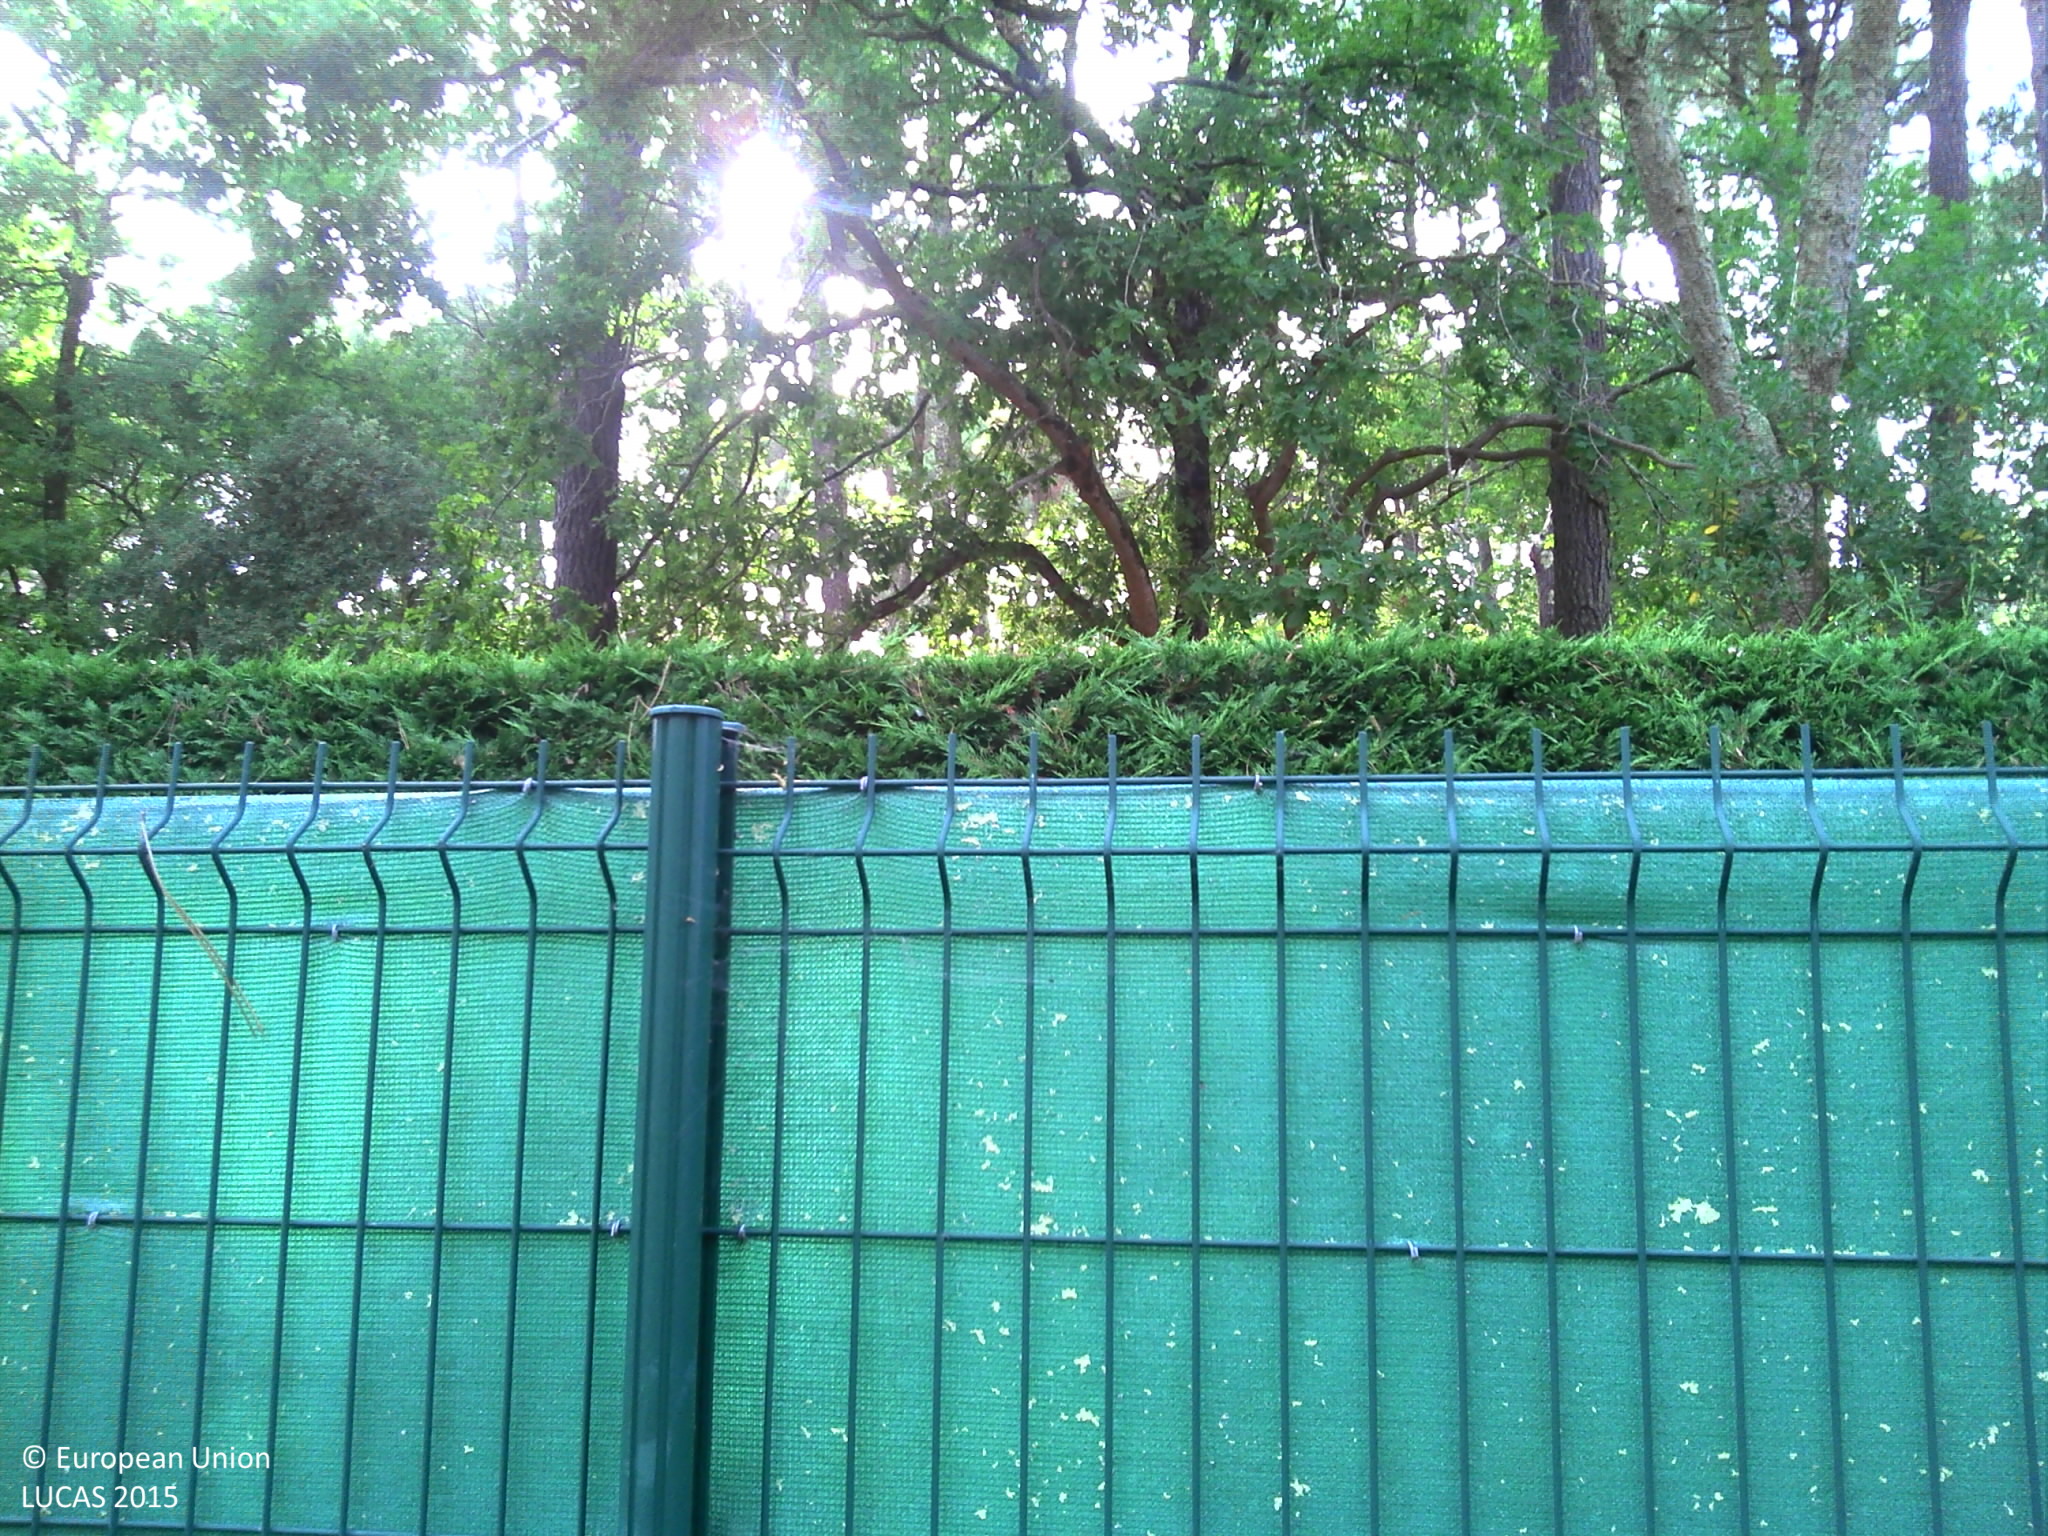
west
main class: Woodland
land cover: Pine dominated mixed woodland
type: coniferous forest of the mediterranean region
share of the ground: > 75 %
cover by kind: coniferous forest trees 50 %, broadleaved forest trees 25 %, herbaceous plants 15 %, unconsolidated bare surface 10 %
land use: Residential
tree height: > 5 m
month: July
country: FR
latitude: 43.9062
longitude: -1.3633
